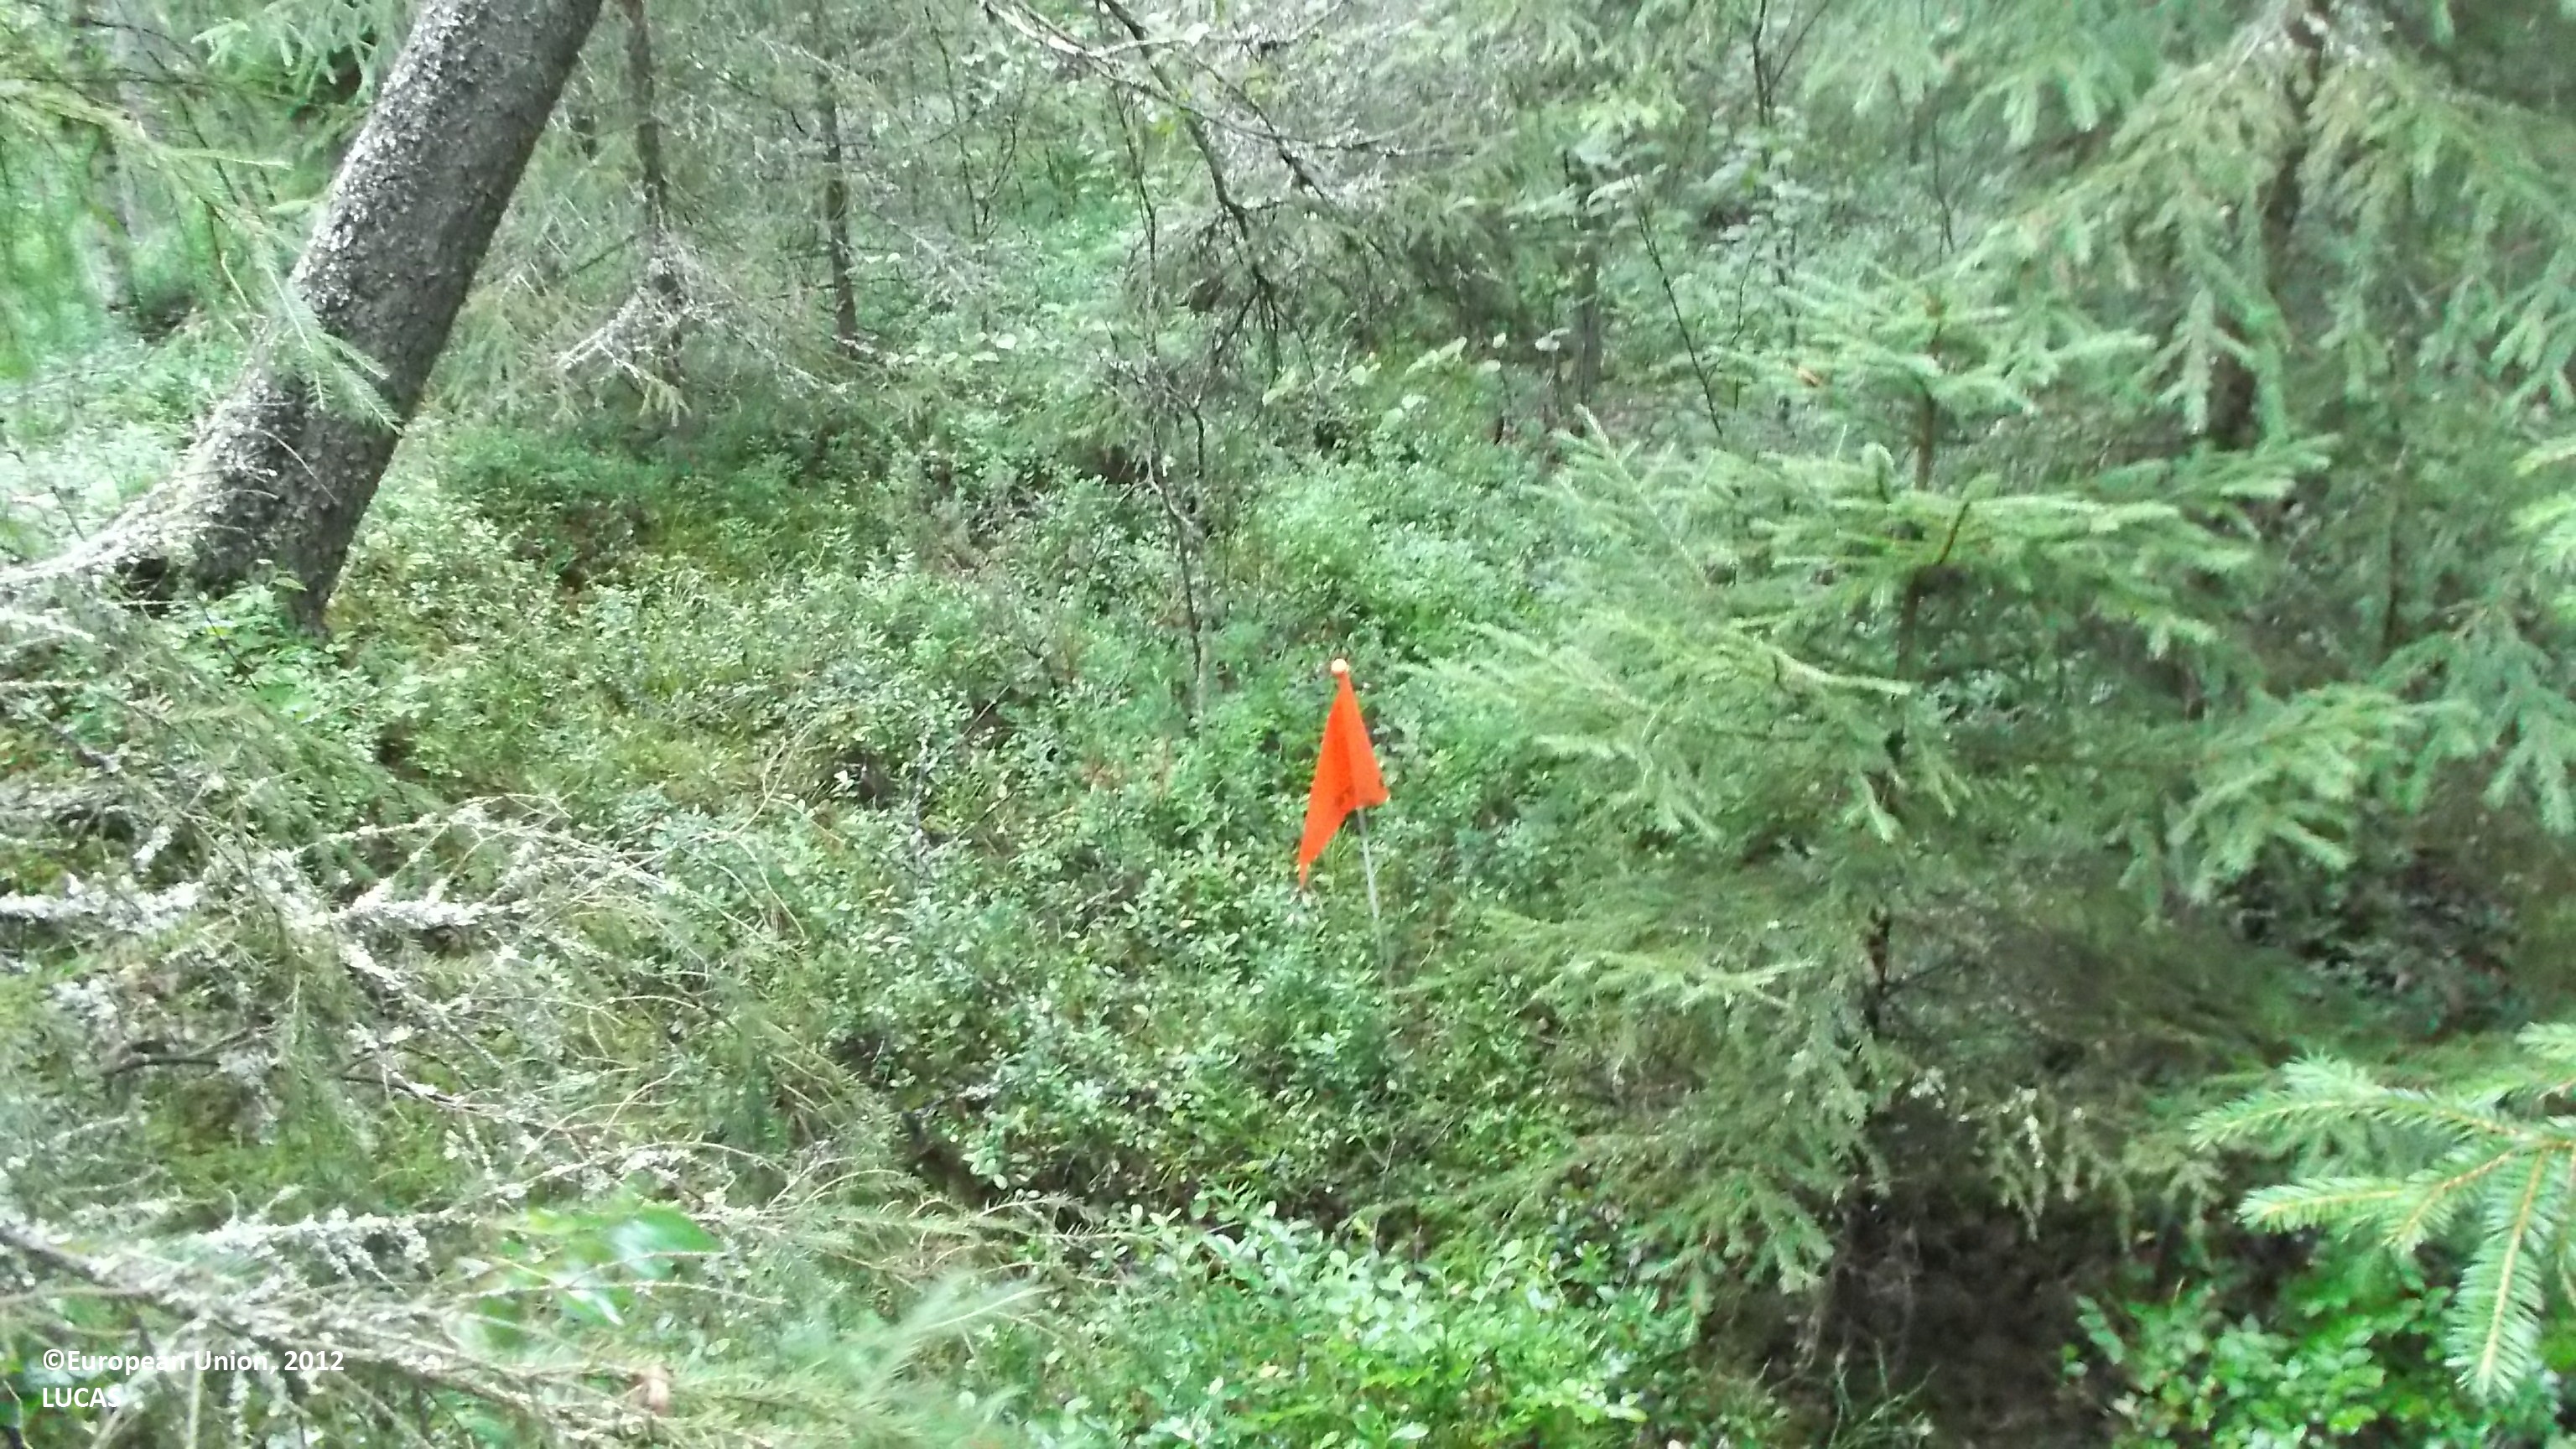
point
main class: Woodland
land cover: Spruce dominated mixed woodland
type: boreal forest
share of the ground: > 75 %
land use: Forestry
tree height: > 5 m
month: August
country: FI
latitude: 63.7657
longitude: 23.2554
